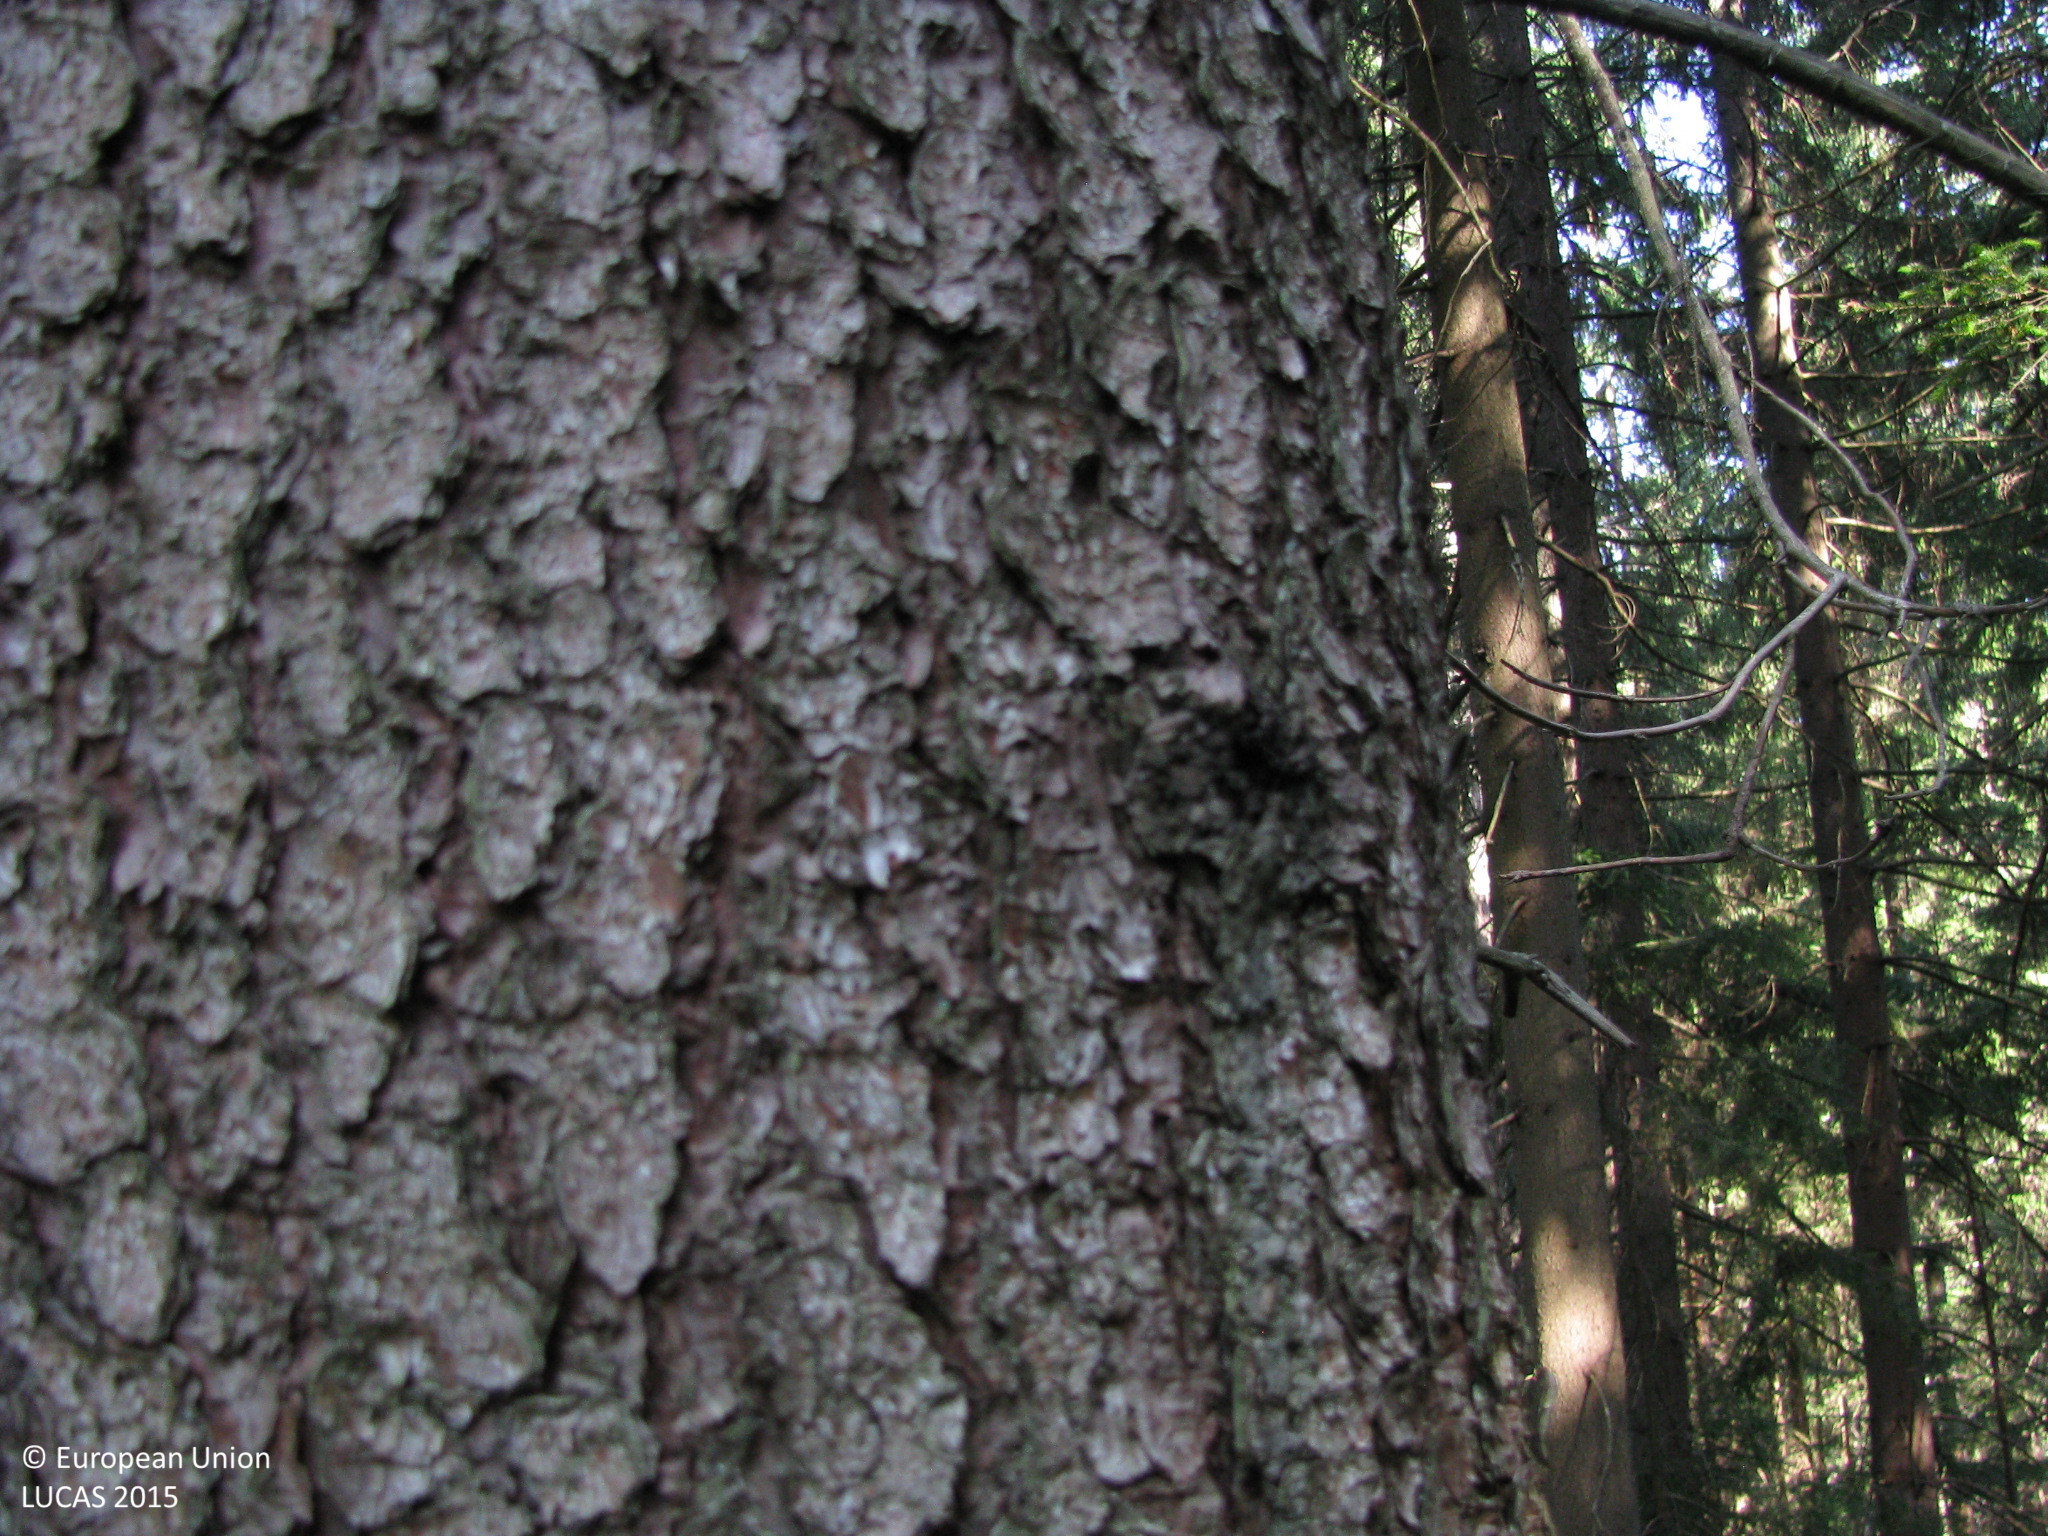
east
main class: Woodland
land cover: Spruce dominated coniferous woodland
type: alpine coniferous forest
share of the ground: > 75 %
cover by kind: coniferous forest trees 90 %, herbaceous plants 5 %, lichens and mosses 5 %
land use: Forestry
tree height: > 5 m
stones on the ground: < 10 %
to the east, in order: Spruce dominated coniferous woodland; Tracks; Spruce dominated coniferous woodland; Fences; Spruce dominated coniferous woodland; Tracks; Grassland with sparse tree/shrub cover; Electric lines; Grassland with sparse tree/shrub cover; Tracks; Spruce dominated coniferous woodland; Fences; Grassland without tree/shrub cover
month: July
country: AT
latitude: 47.0765
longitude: 14.7267
